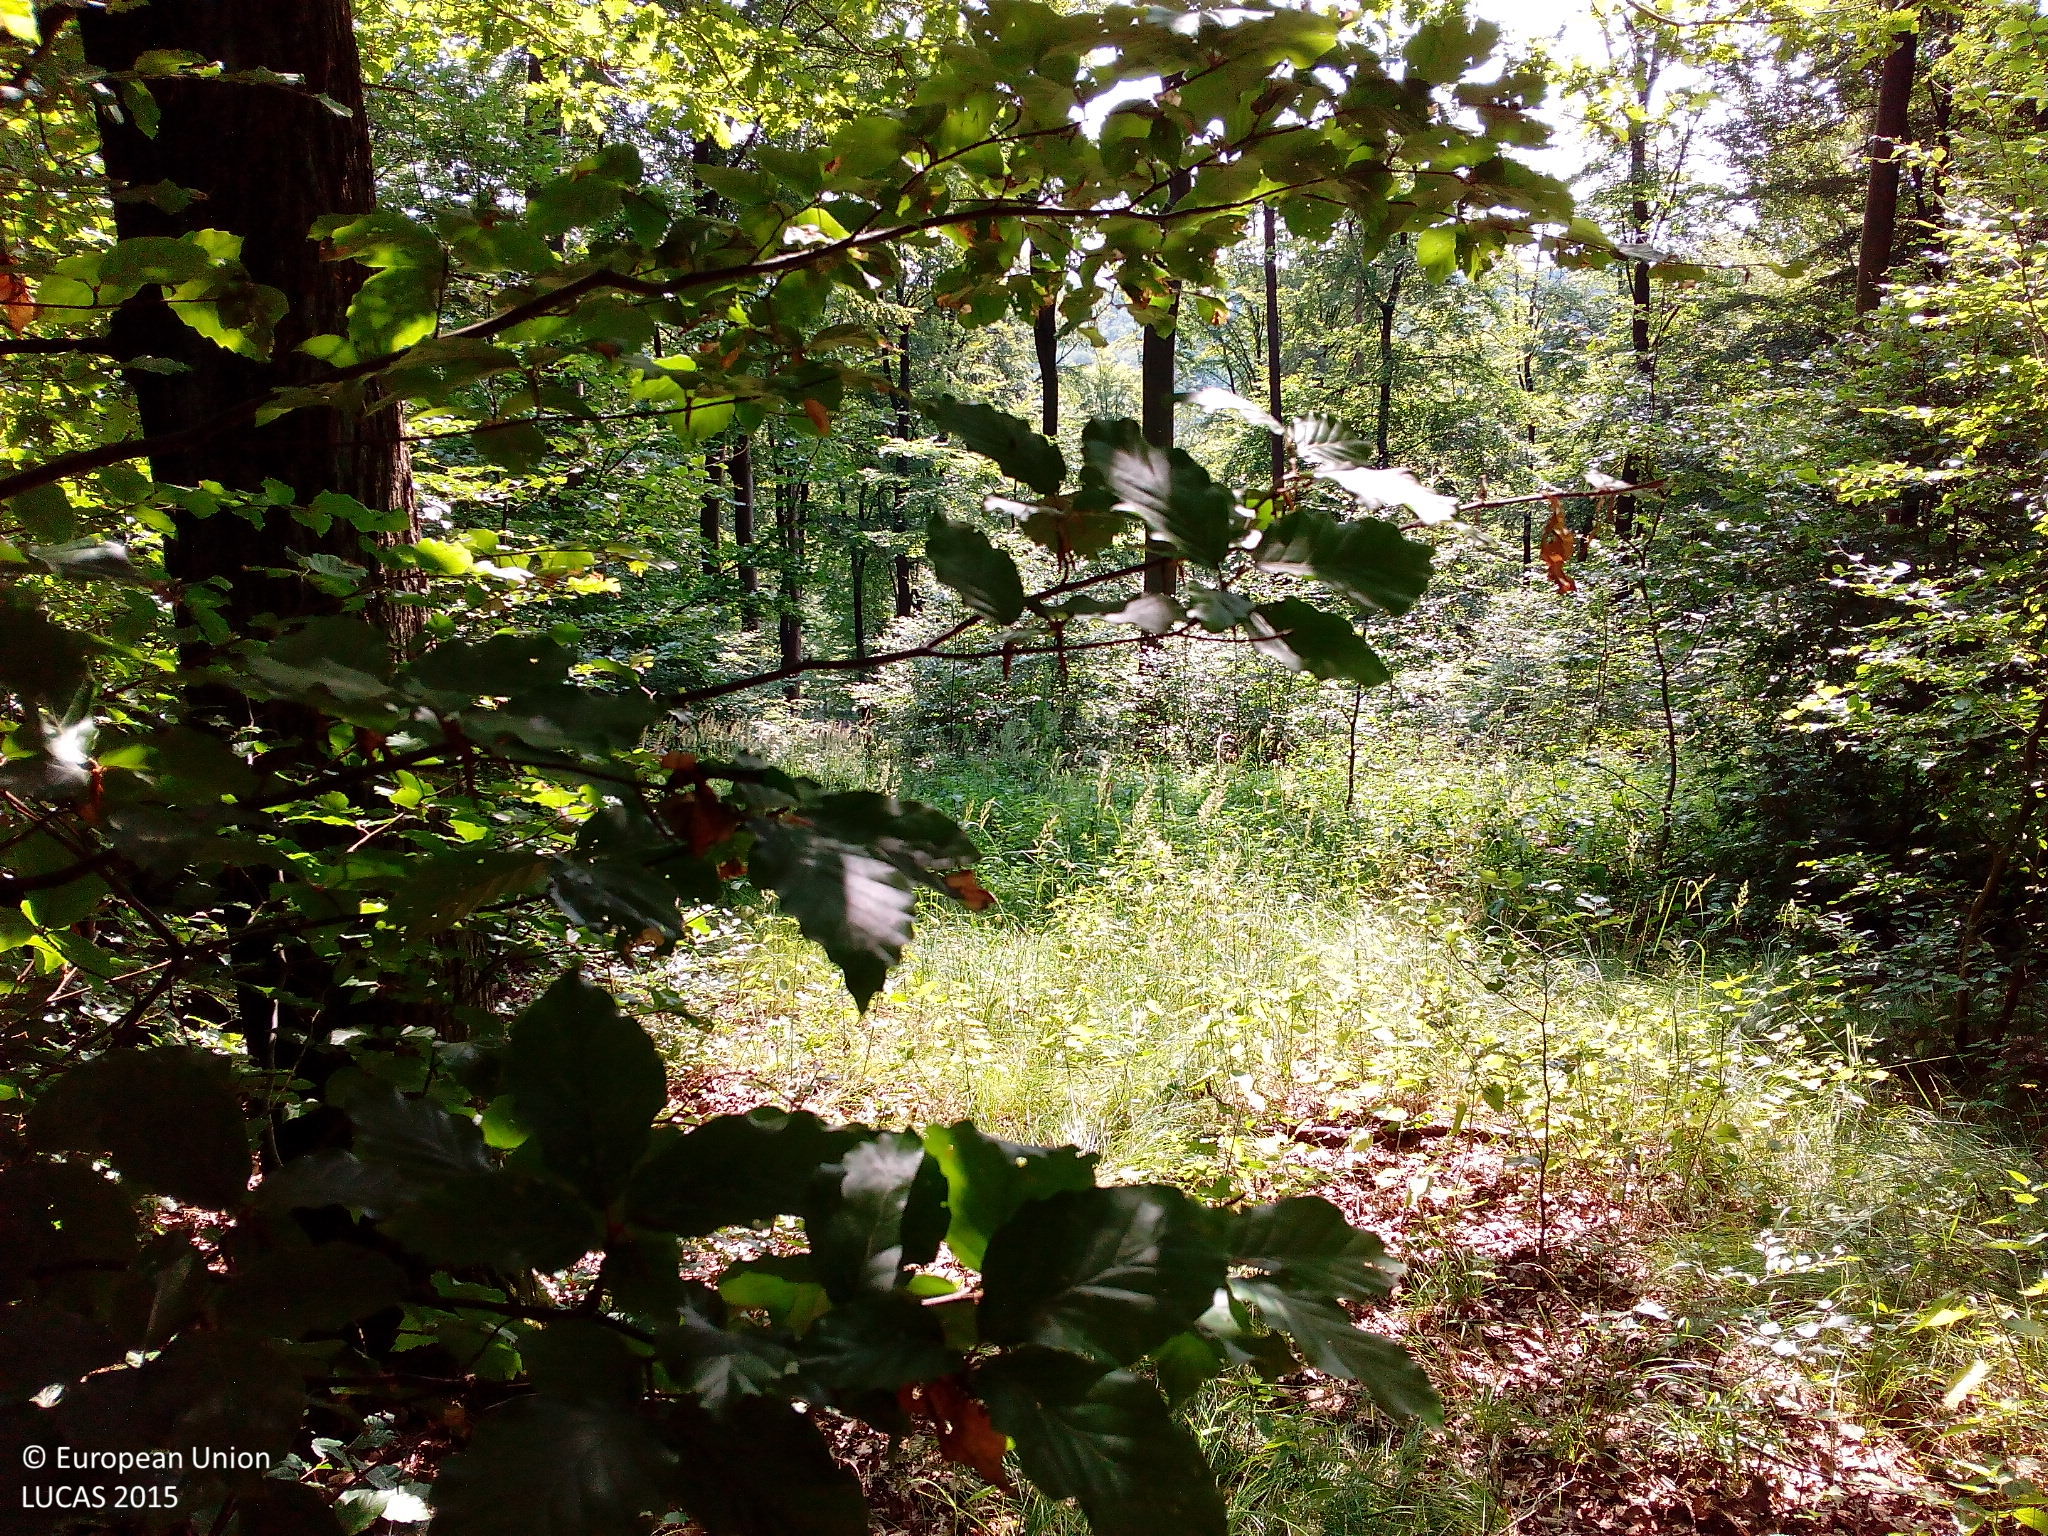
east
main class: Woodland
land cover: Broadleaved woodland
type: beech forest
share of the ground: > 75 %
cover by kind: broadleaved forest trees 80 %, herbaceous plants 15 %, unconsolidated bare surface 5 %
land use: Forestry
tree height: > 5 m
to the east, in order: Broadleaved woodland; Tracks; Broadleaved woodland
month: July
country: DE
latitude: 50.9033
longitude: 9.8436
